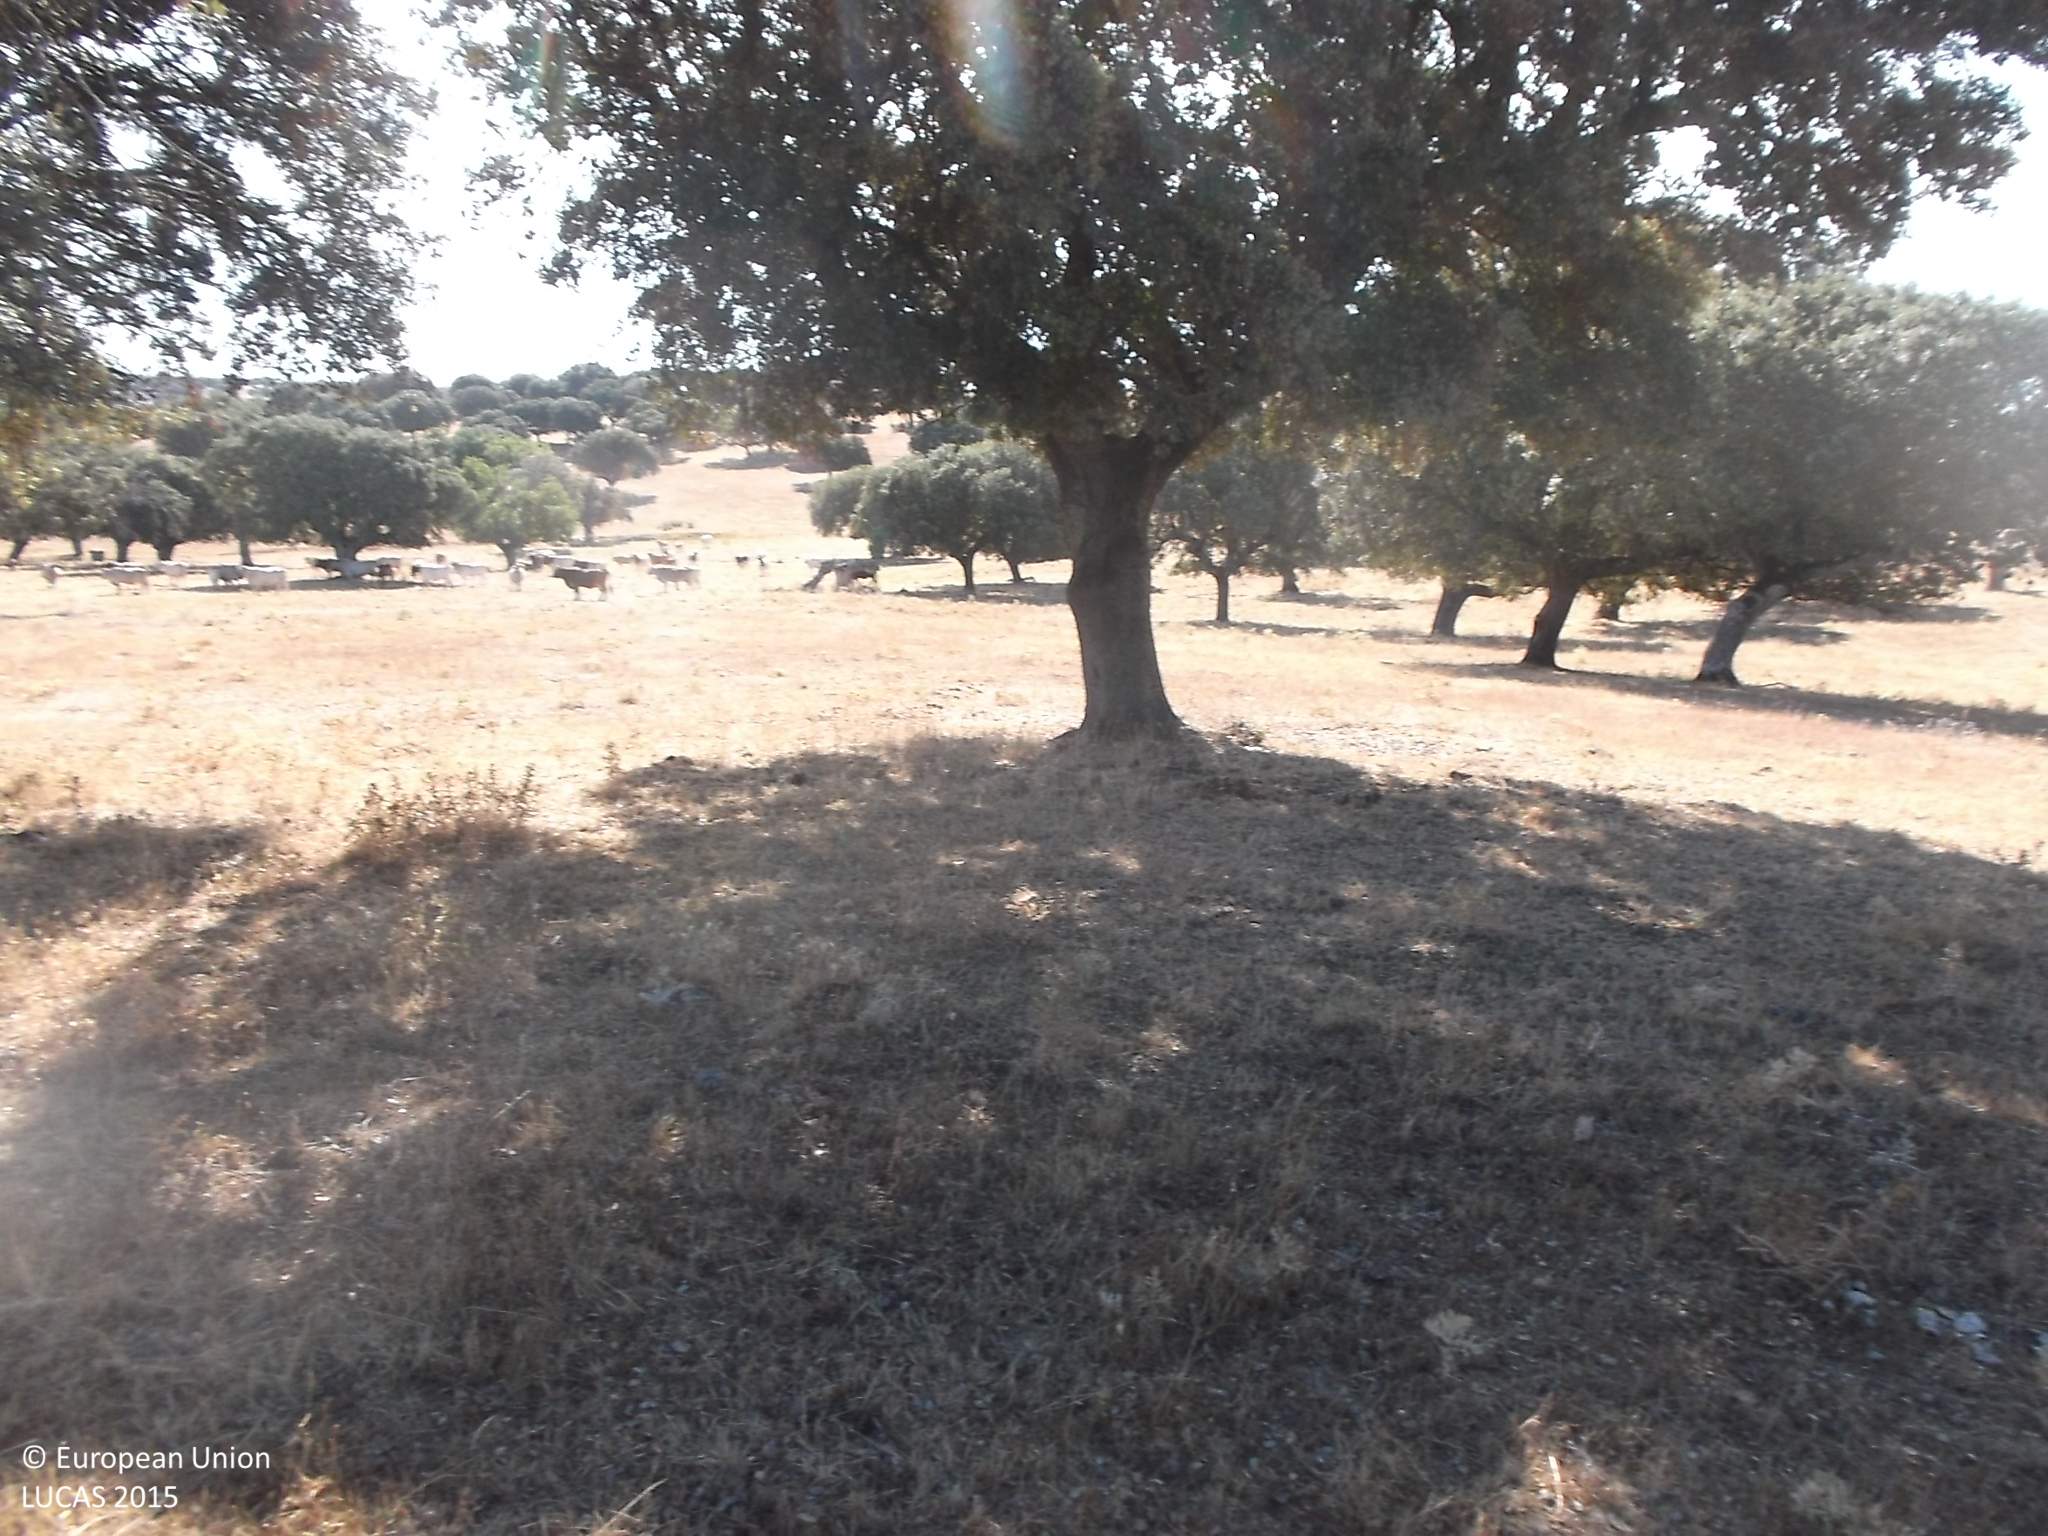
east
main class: Woodland
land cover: Broadleaved woodland
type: broadleaved evergreen forest
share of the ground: 10 - 25 %
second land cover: Grassland without tree/shrub cover
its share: > 75 %
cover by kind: herbaceous plants 85 %, broadleaved forest trees 15 %
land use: Forestry
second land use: Agriculture (excluding fallow land and kitchen gardens)
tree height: < 5 m
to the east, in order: Broadleaved woodland; Grassland without tree/shrub cover; Tracks; Grassland without tree/shrub cover
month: July
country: ES
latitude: 40.8837
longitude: -6.2882
